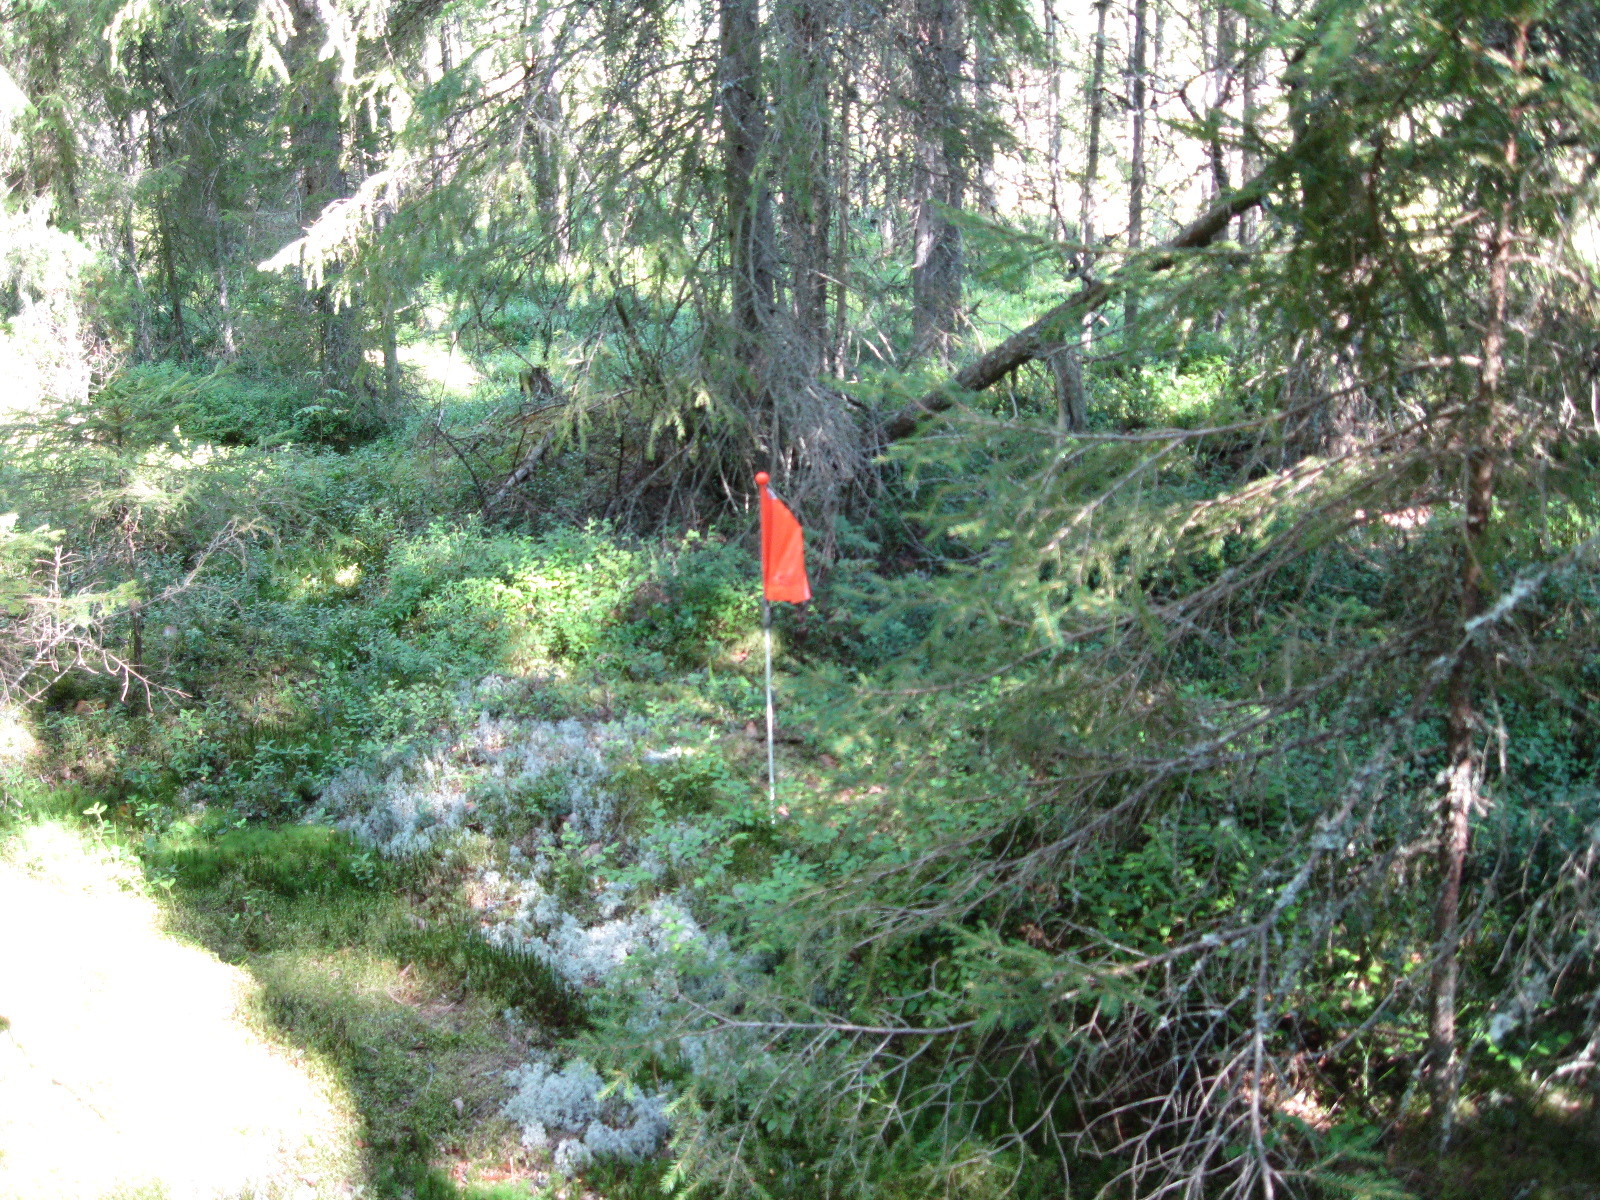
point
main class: Woodland
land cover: Other coniferous woodland
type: boreal forest
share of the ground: 50 - 75 %
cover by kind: coniferous forest trees 50 %, lichens and mosses 25 %, shrubs 15 %, broadleaved forest trees 10 %
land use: Forestry
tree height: > 5 m
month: August
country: FI
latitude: 61.4535
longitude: 25.1387
